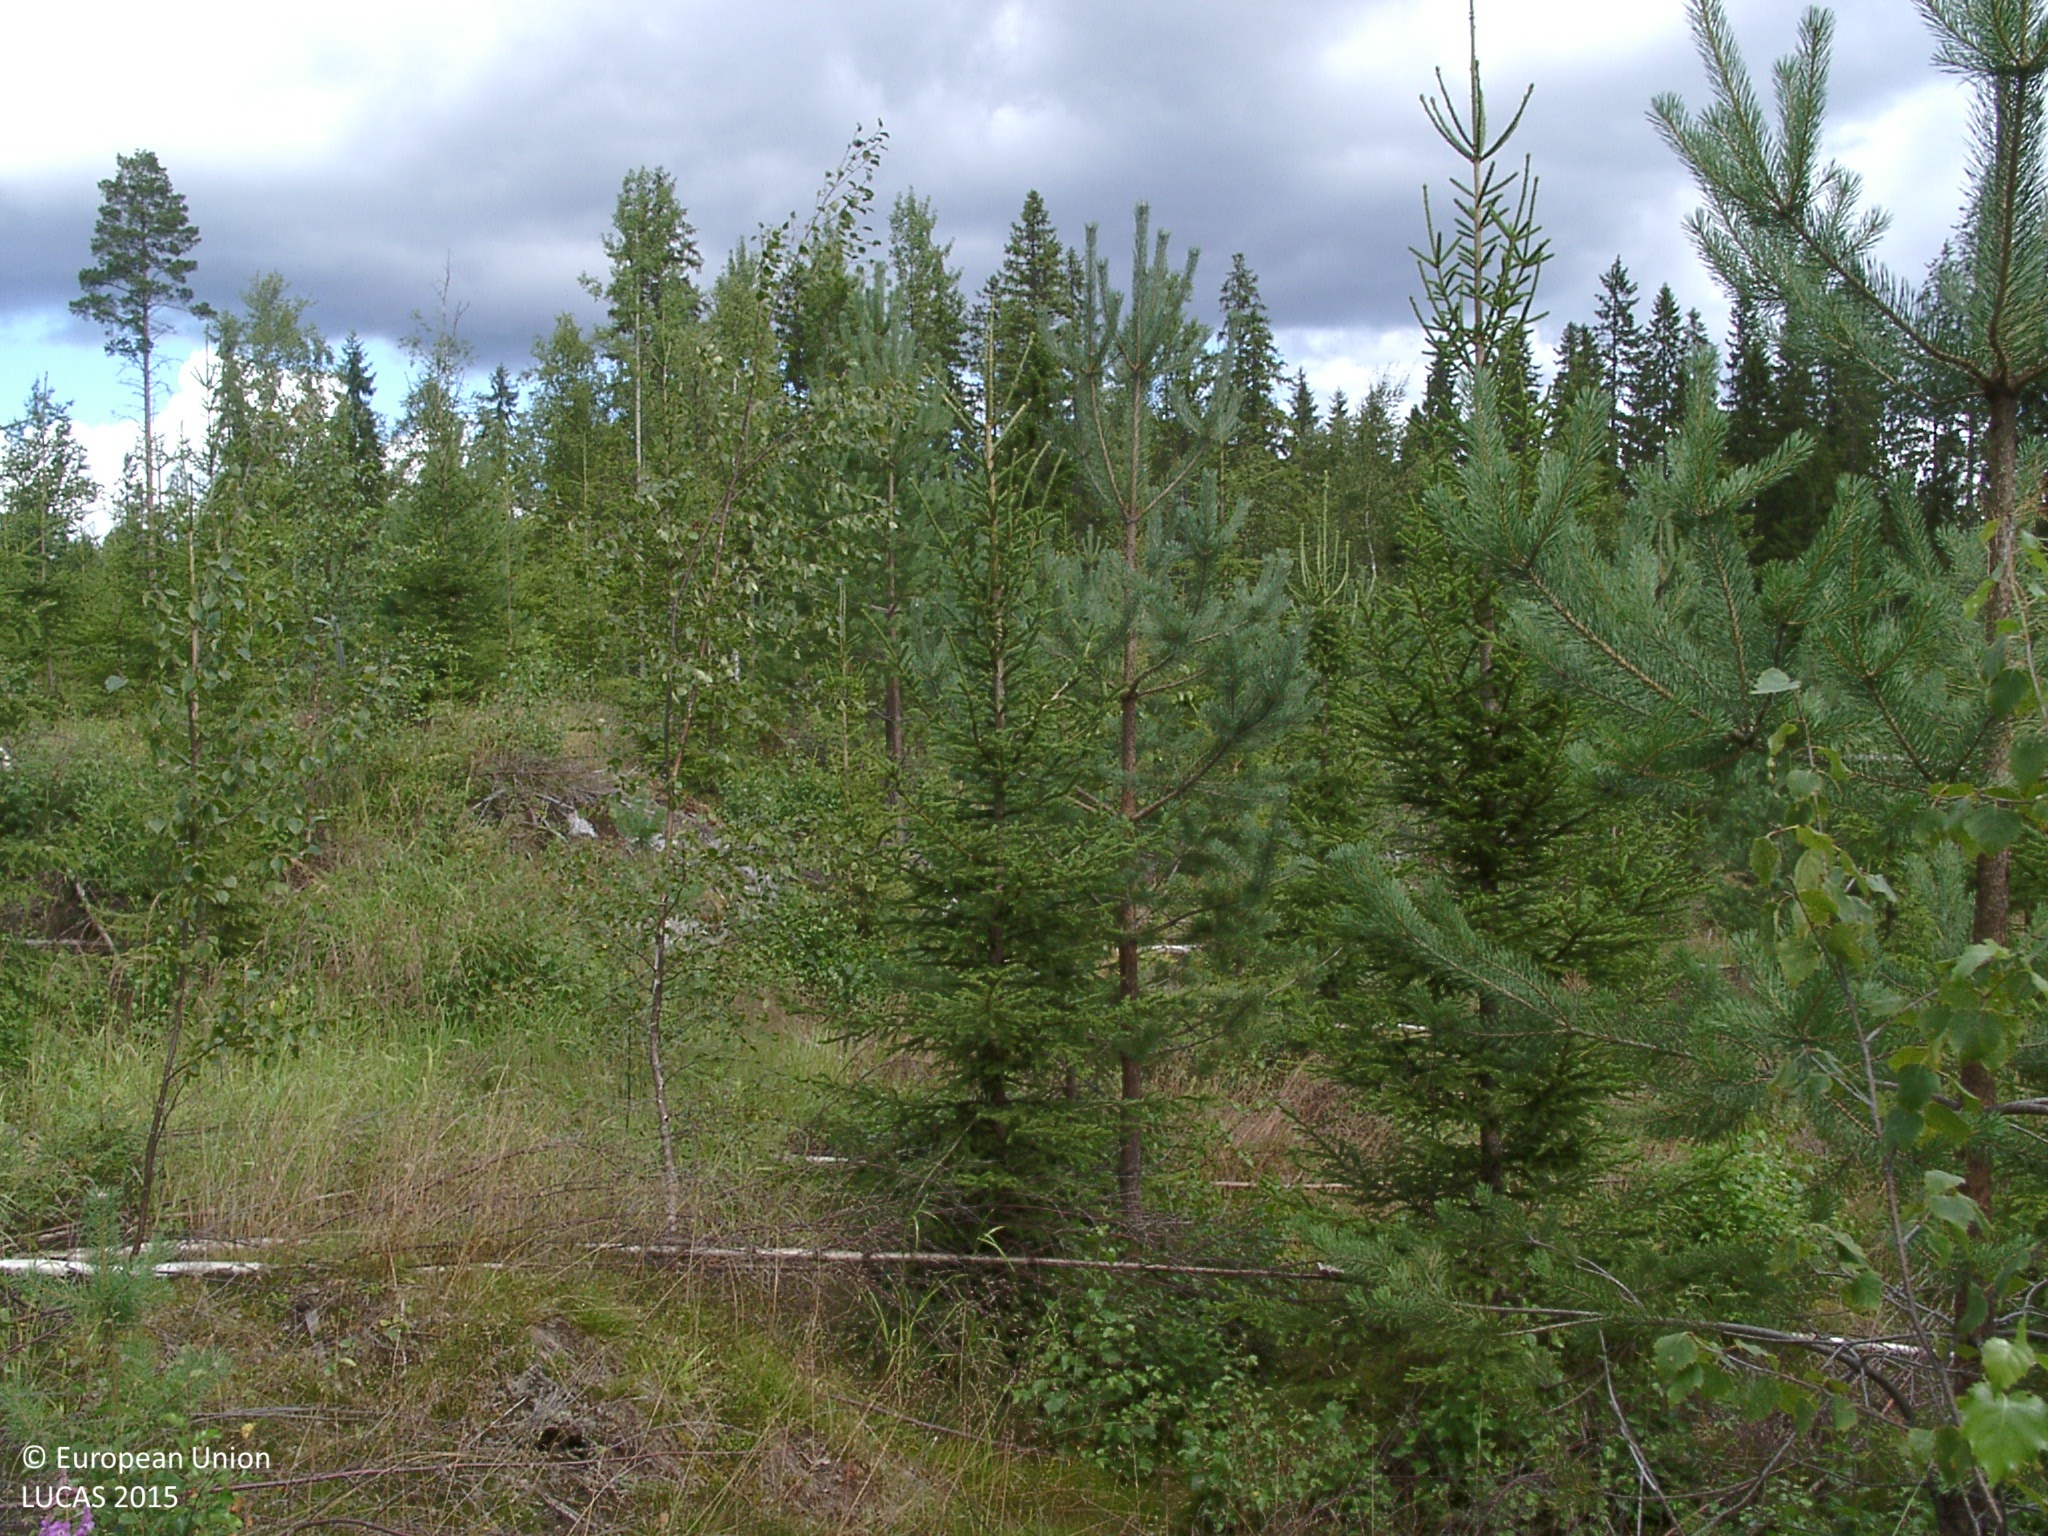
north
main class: Woodland
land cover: Other coniferous woodland
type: boreal forest
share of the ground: 50 - 75 %
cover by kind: coniferous forest trees 50 %, broadleaved forest trees 15 %, shrubs 10 %, herbaceous plants 10 %, lichens and mosses 5 %
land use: Forestry
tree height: < 5 m
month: August
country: FI
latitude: 62.3467
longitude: 25.5855
